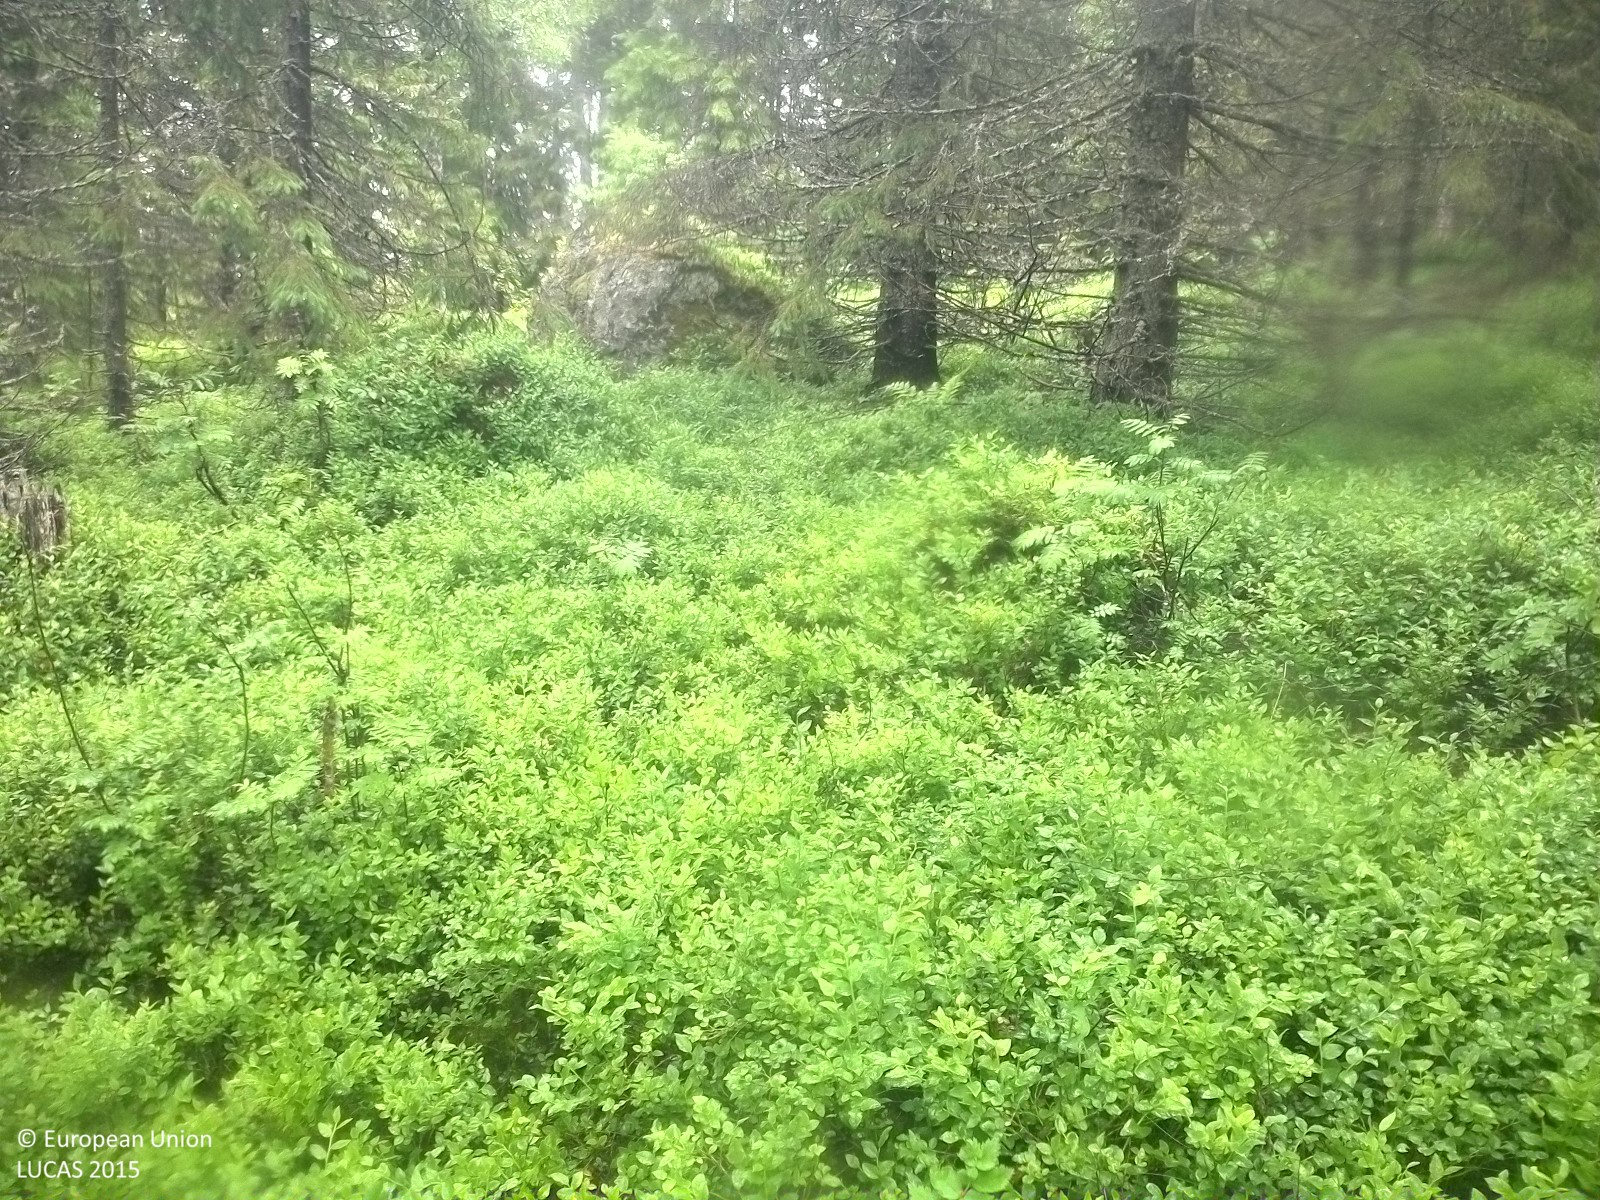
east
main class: Woodland
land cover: Spruce dominated mixed woodland
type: boreal forest
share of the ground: 25 - 50 %
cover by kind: shrubs 50 %, coniferous forest trees 35 %, broadleaved forest trees 15 %
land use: Forestry
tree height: > 5 m
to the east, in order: Spruce dominated mixed woodland; Other mixed woodland; Broadleaved woodland
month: July
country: SE
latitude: 62.4721
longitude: 16.9033
